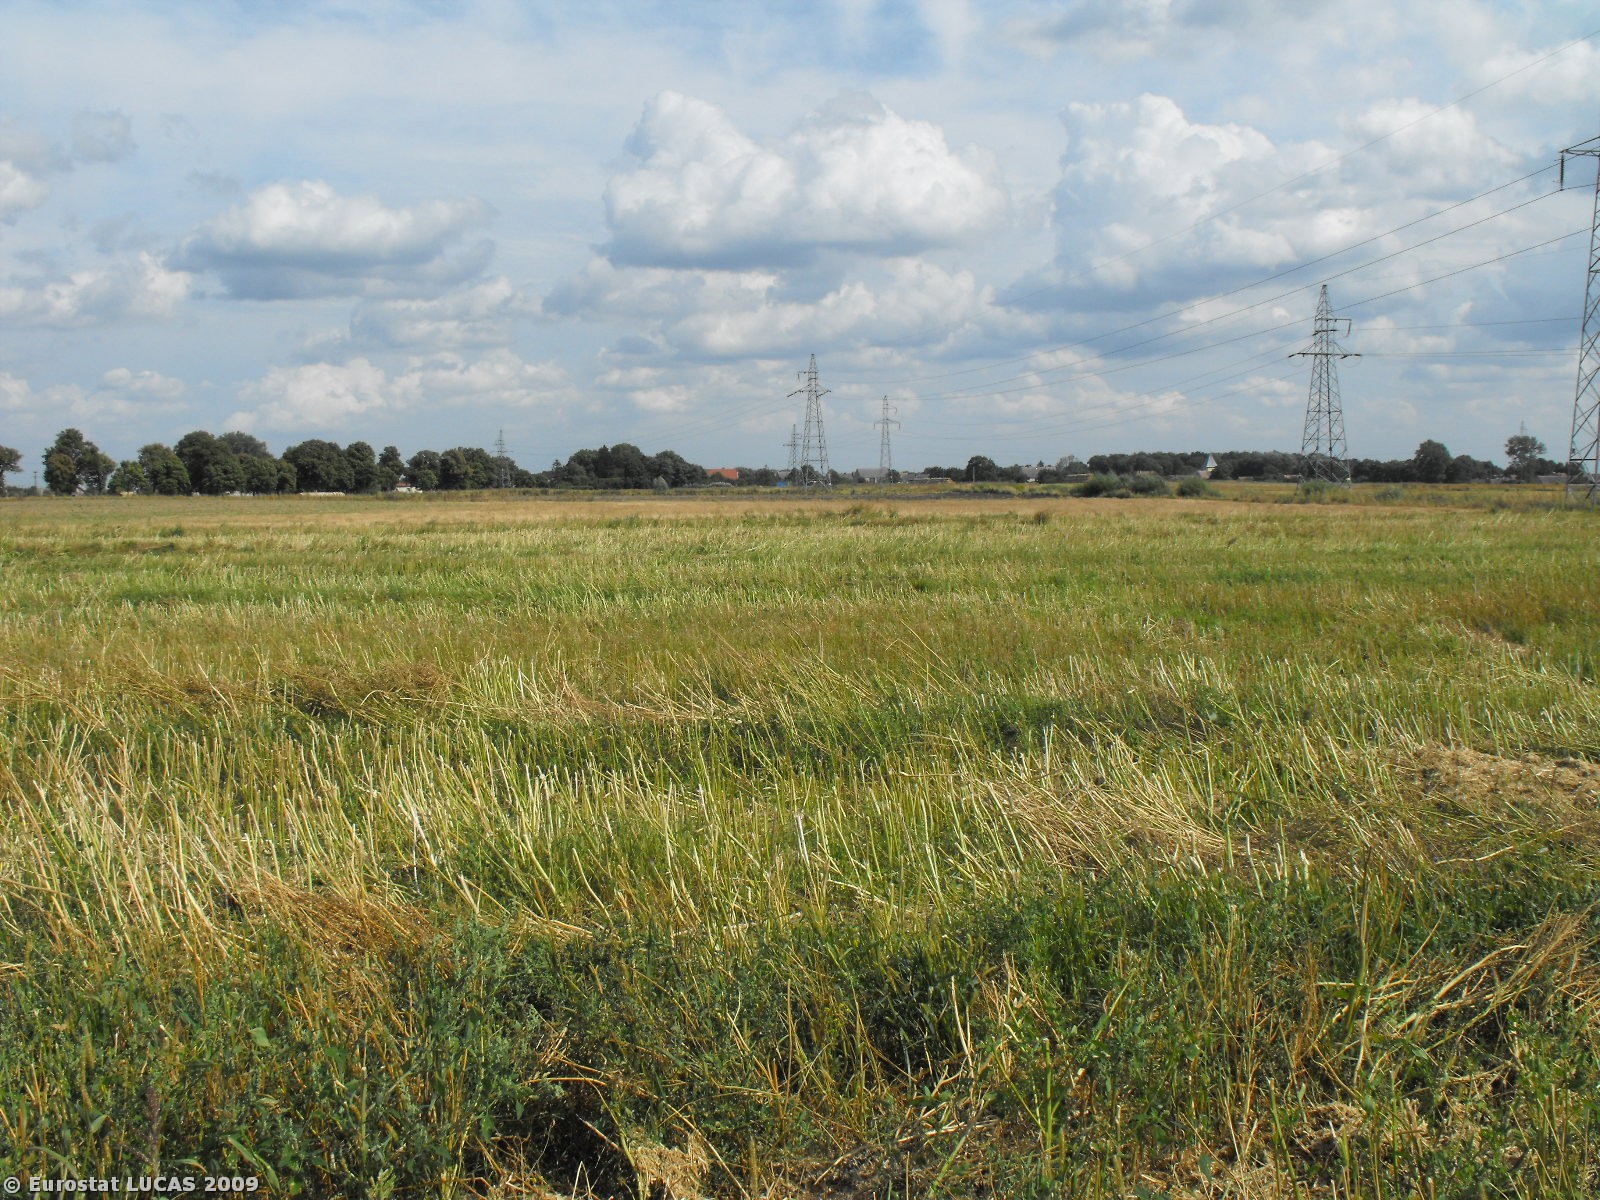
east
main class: Cropland
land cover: Rape and turnip rape
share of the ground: < 10 %
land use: Agriculture (excluding fallow land and kitchen gardens)
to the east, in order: Rape and turnip rape; Triticale; Barley
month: August
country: PL
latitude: 53.0456
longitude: 16.5257
